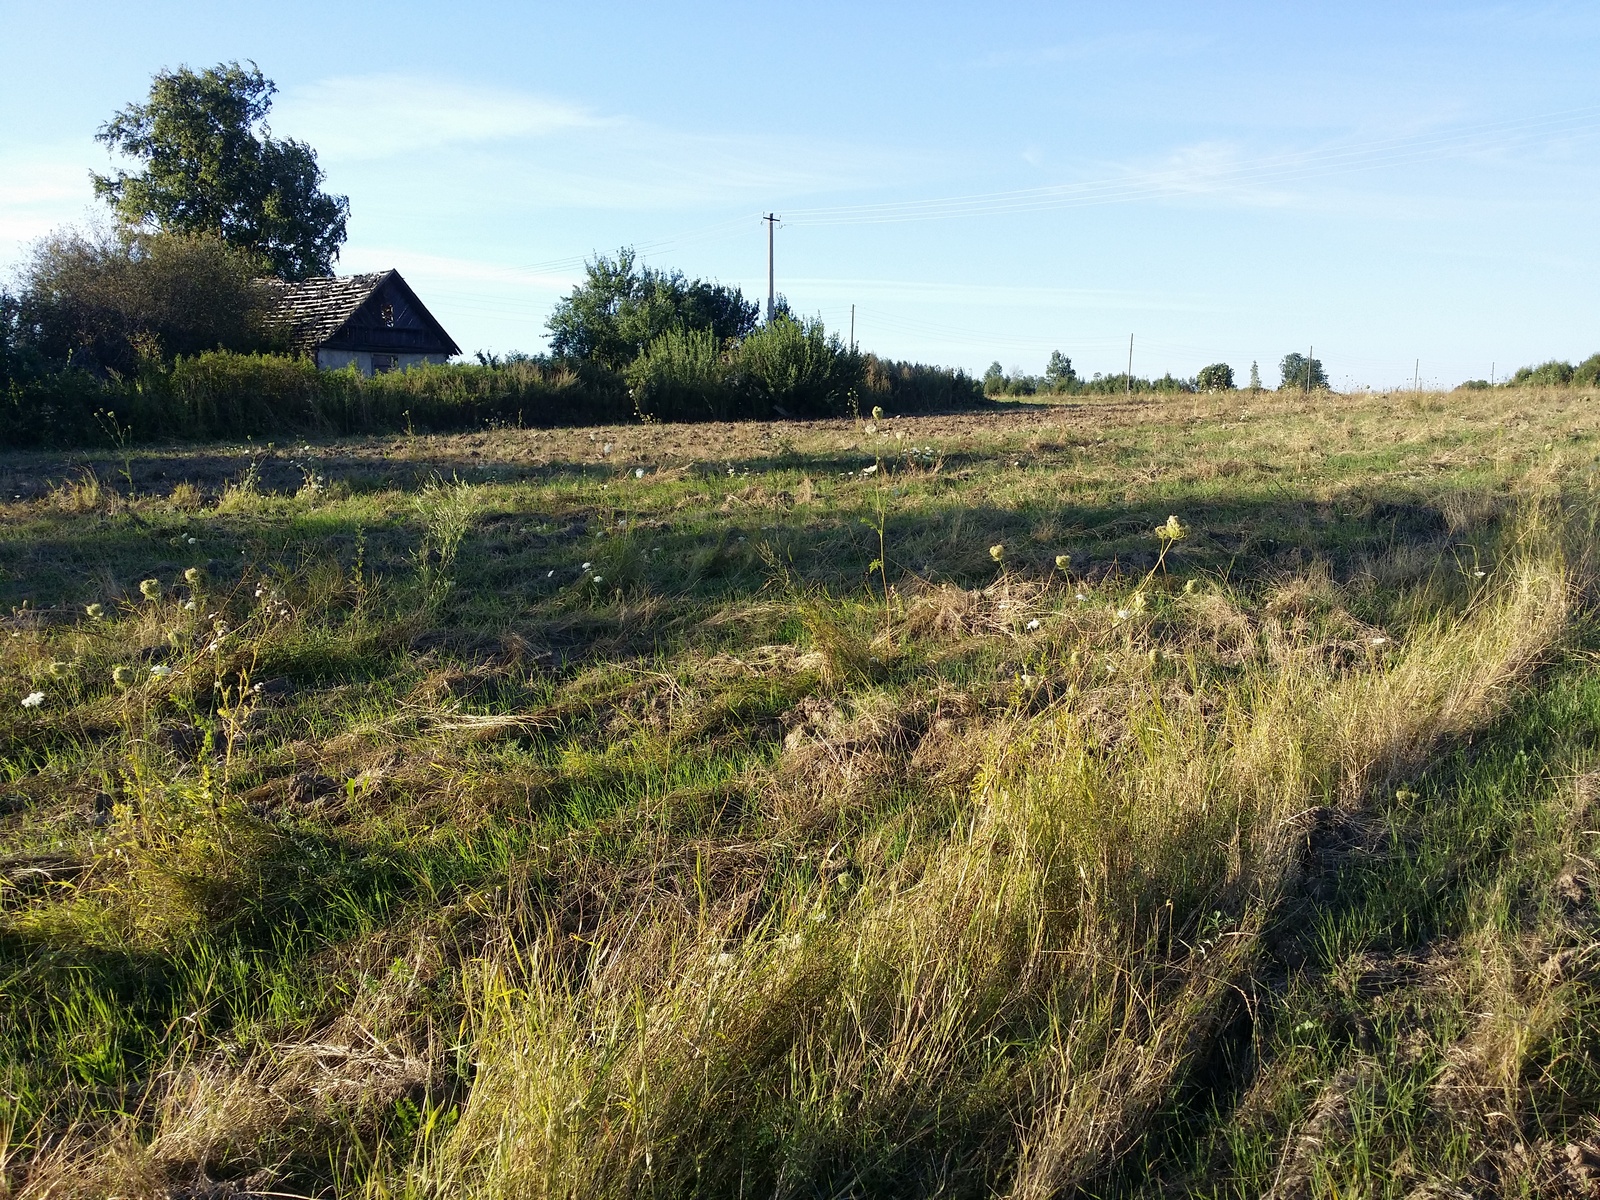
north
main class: Grassland
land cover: Grassland without tree/shrub cover
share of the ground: > 75 %
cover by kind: herbaceous plants 95 %, unconsolidated bare surface 5 %
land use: Agriculture (excluding fallow land and kitchen gardens)
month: August
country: LV
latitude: 57.1253
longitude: 27.6748
